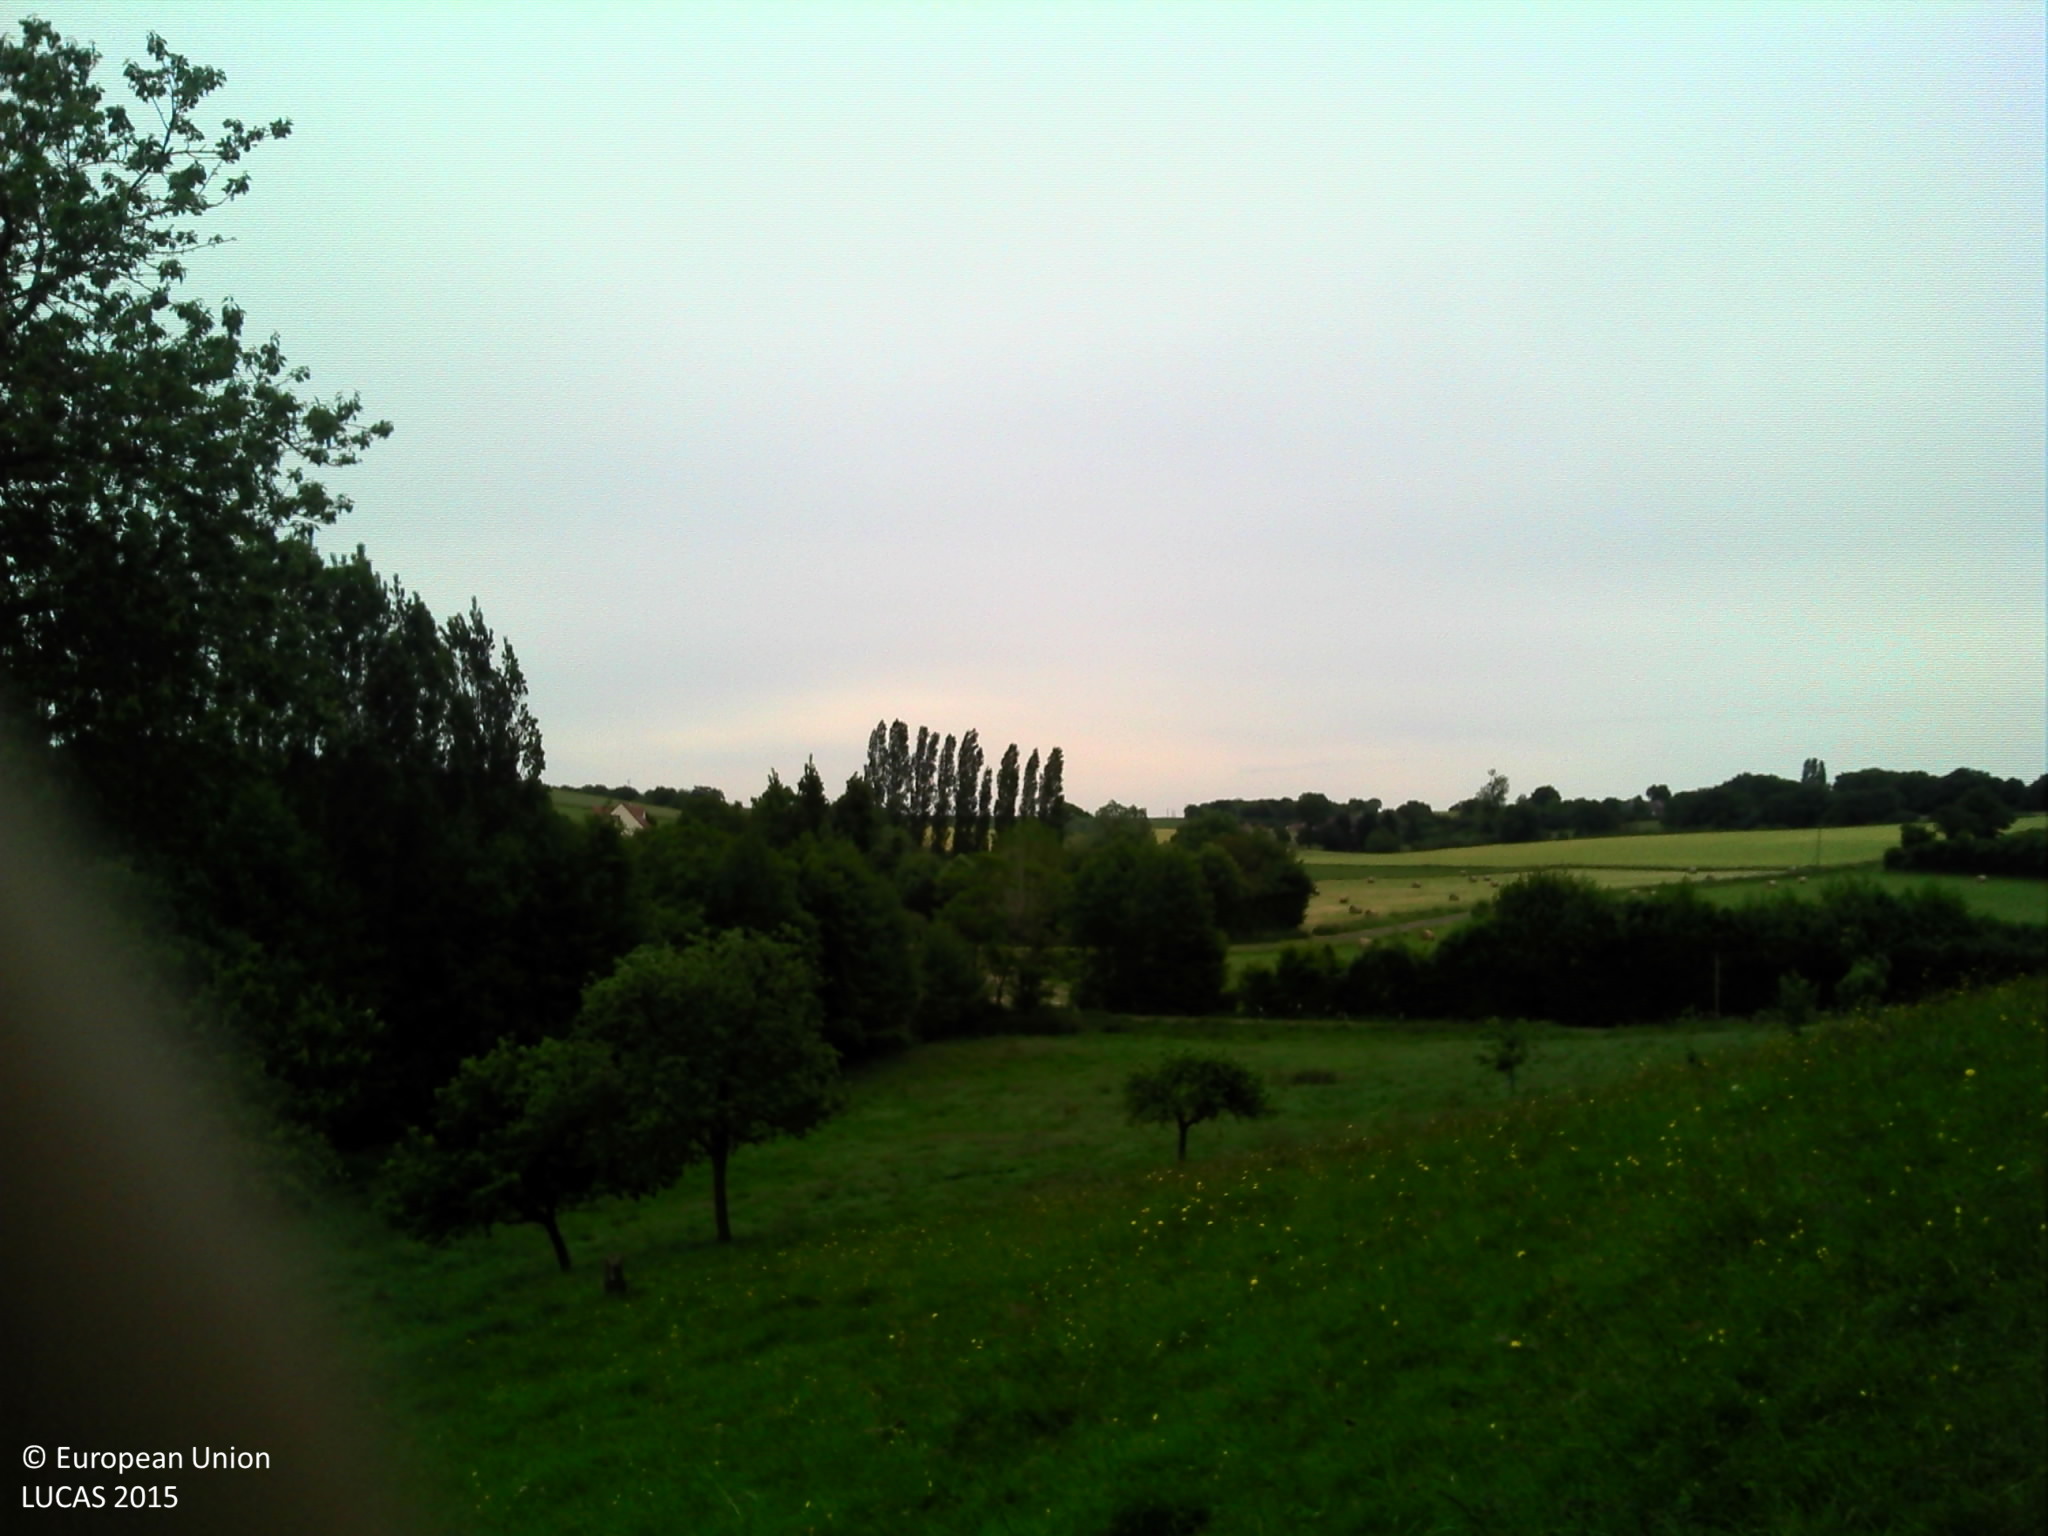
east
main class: Grassland
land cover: Grassland with sparse tree/shrub cover
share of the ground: > 75 %
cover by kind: herbaceous plants 95 %, broadleaved forest trees 5 %
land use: Agriculture (excluding fallow land and kitchen gardens)
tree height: > 5 m
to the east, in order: Grassland with sparse tree/shrub cover; Fences; Grass margins; Tracks; Grass margins; Ditches and canals; Managed hedges; Grassland without tree/shrub cover; Fences; Grassland without tree/shrub cover; Fences; Grass margins; Ditches and canals; Grass margins; Paved roads, cycling and walking lanes; Grass margins; Ditches and canals; Fences; Managed hedges; Inland fresh water bodies; Managed hedges
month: June
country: FR
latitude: 48.2717
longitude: -0.0400
